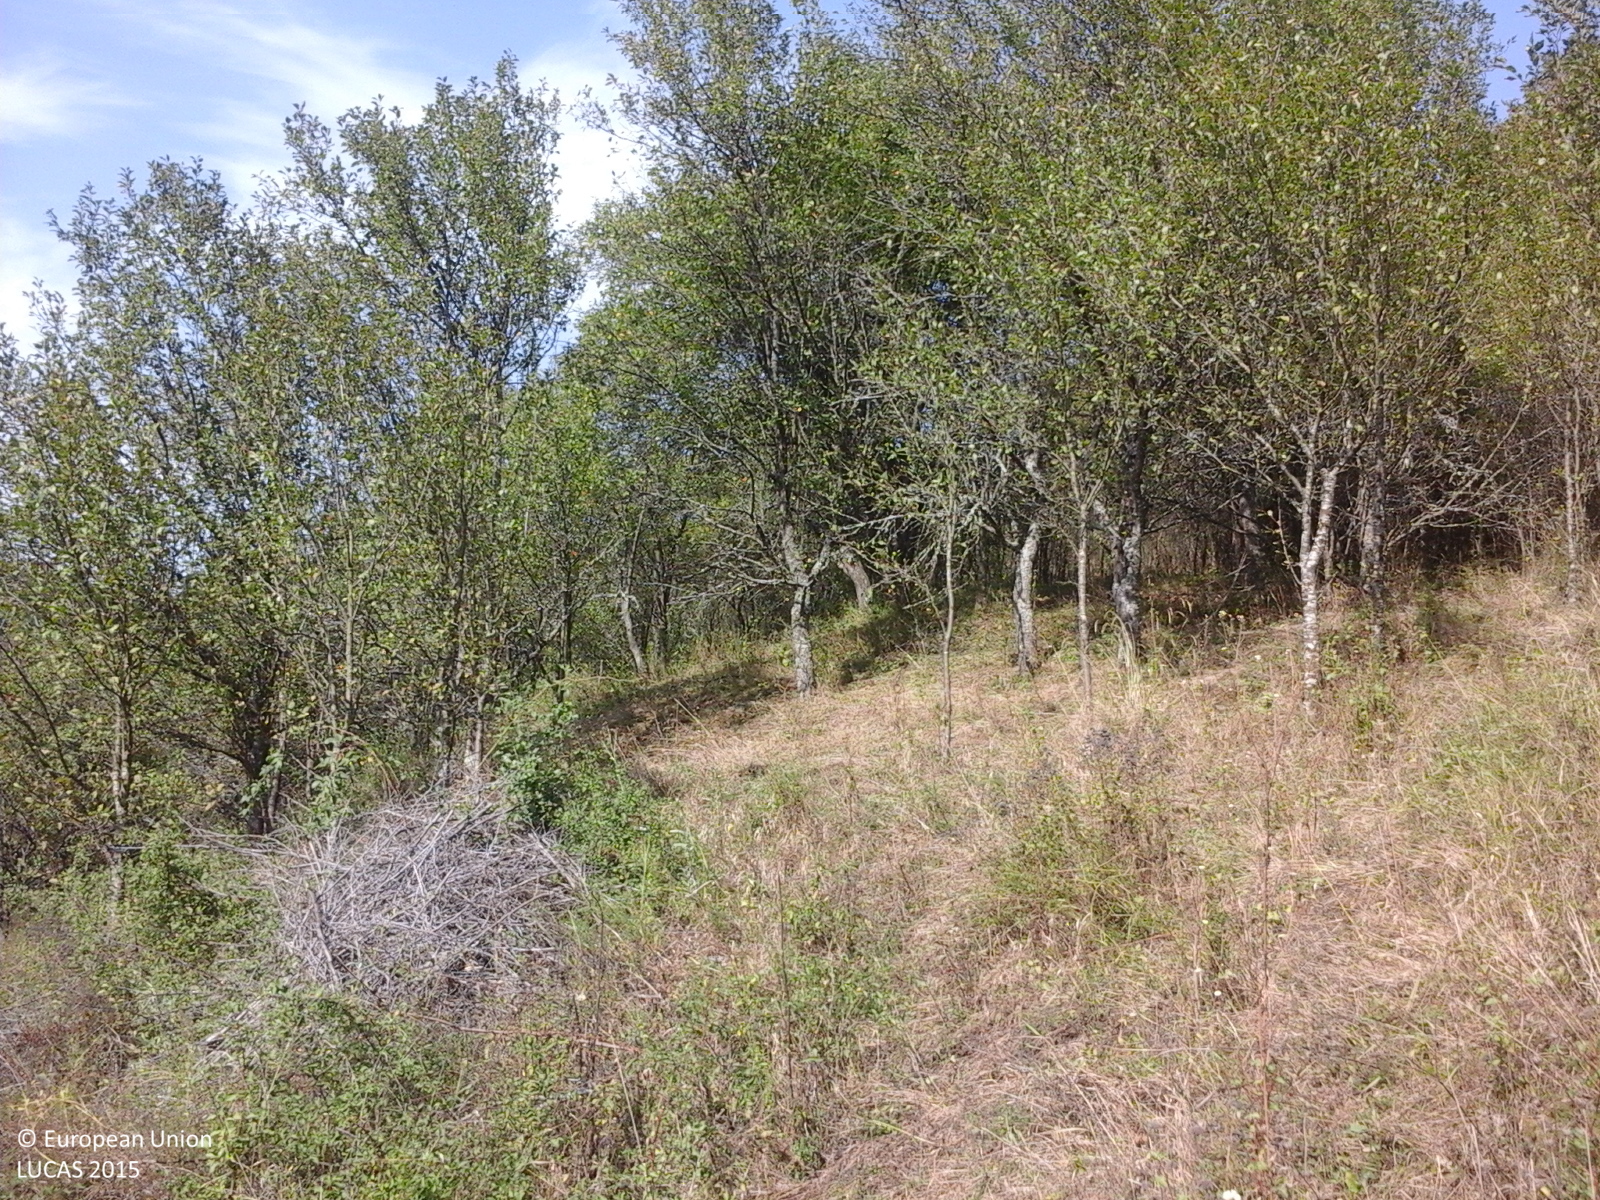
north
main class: Grassland
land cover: Spontaneously vegetated surfaces
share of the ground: > 75 %
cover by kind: herbaceous plants 100 %
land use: Fallow land
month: September
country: RO
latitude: 47.2394
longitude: 23.6686
